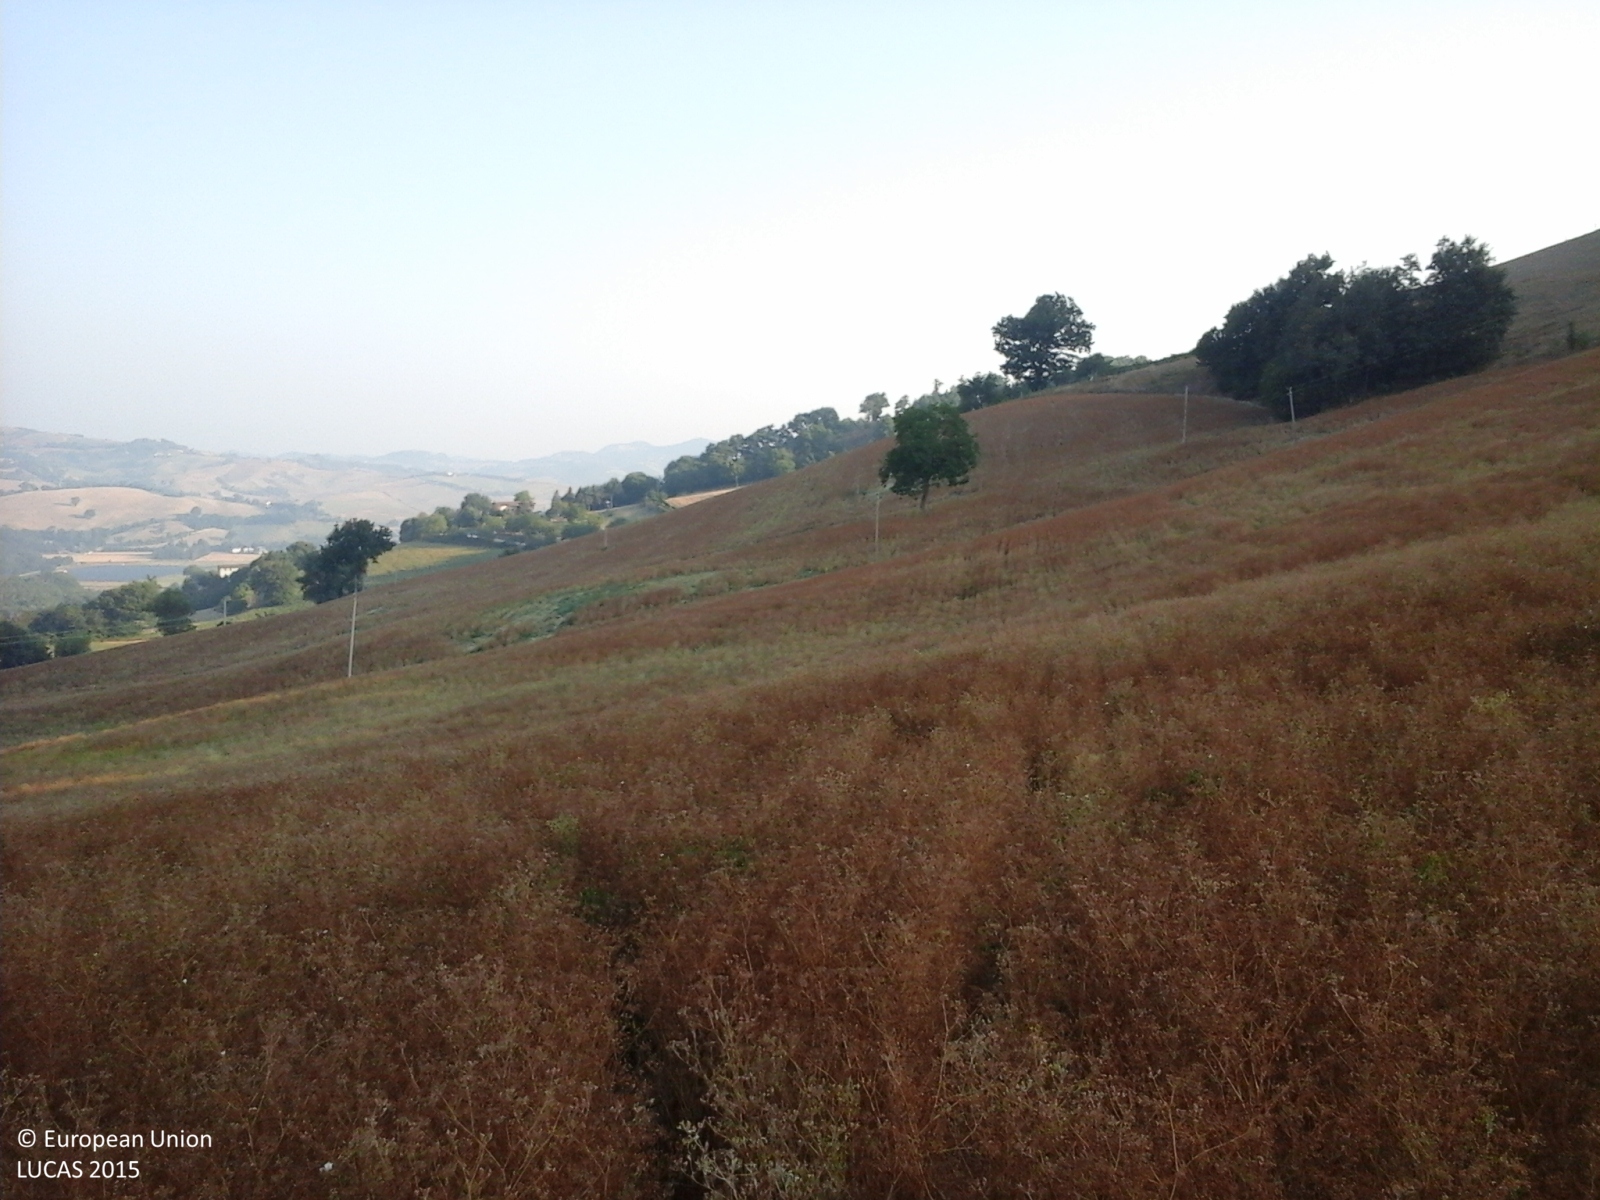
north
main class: Cropland
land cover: Other non-permanent industrial crops
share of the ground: > 75 %
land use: Agriculture (excluding fallow land and kitchen gardens)
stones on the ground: < 10 %
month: August
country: IT
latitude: 43.6319
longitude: 12.6087
